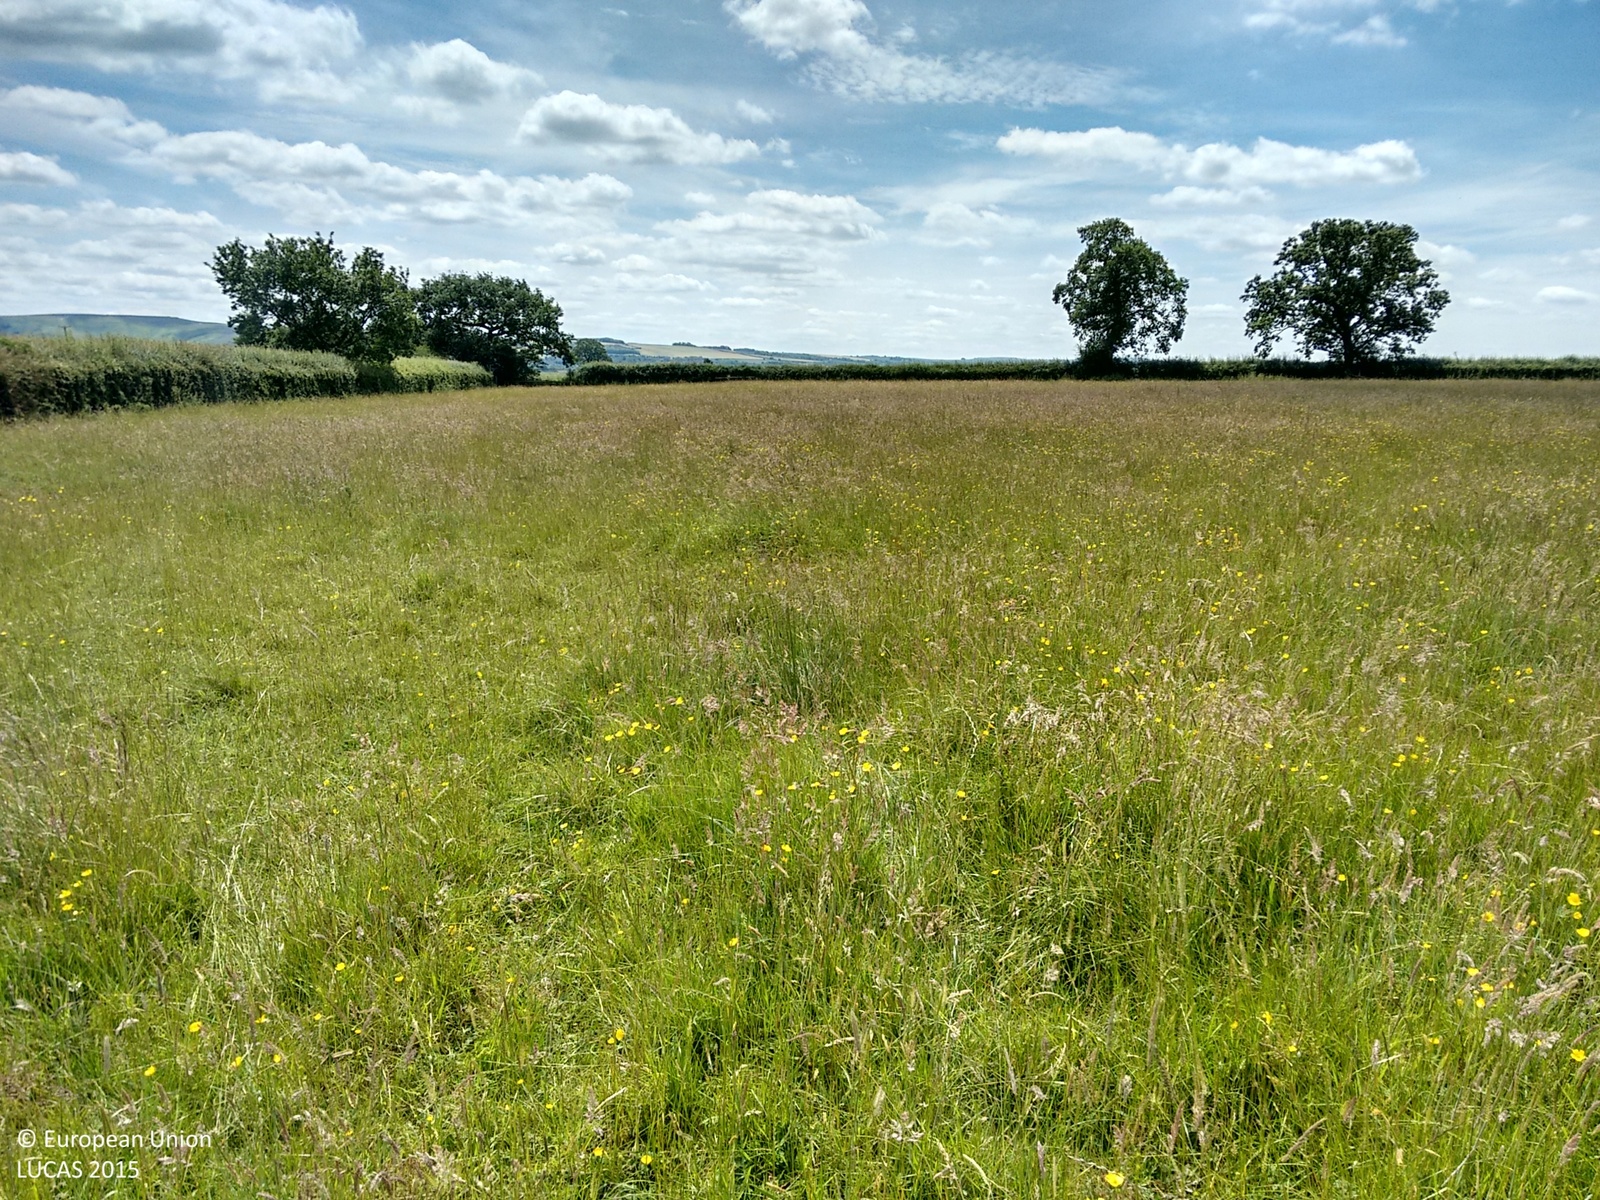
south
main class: Grassland
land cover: Grassland without tree/shrub cover
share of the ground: > 75 %
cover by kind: herbaceous plants 100 %
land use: Agriculture (excluding fallow land and kitchen gardens)
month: June
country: GB
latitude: 51.6254
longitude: -1.5943
